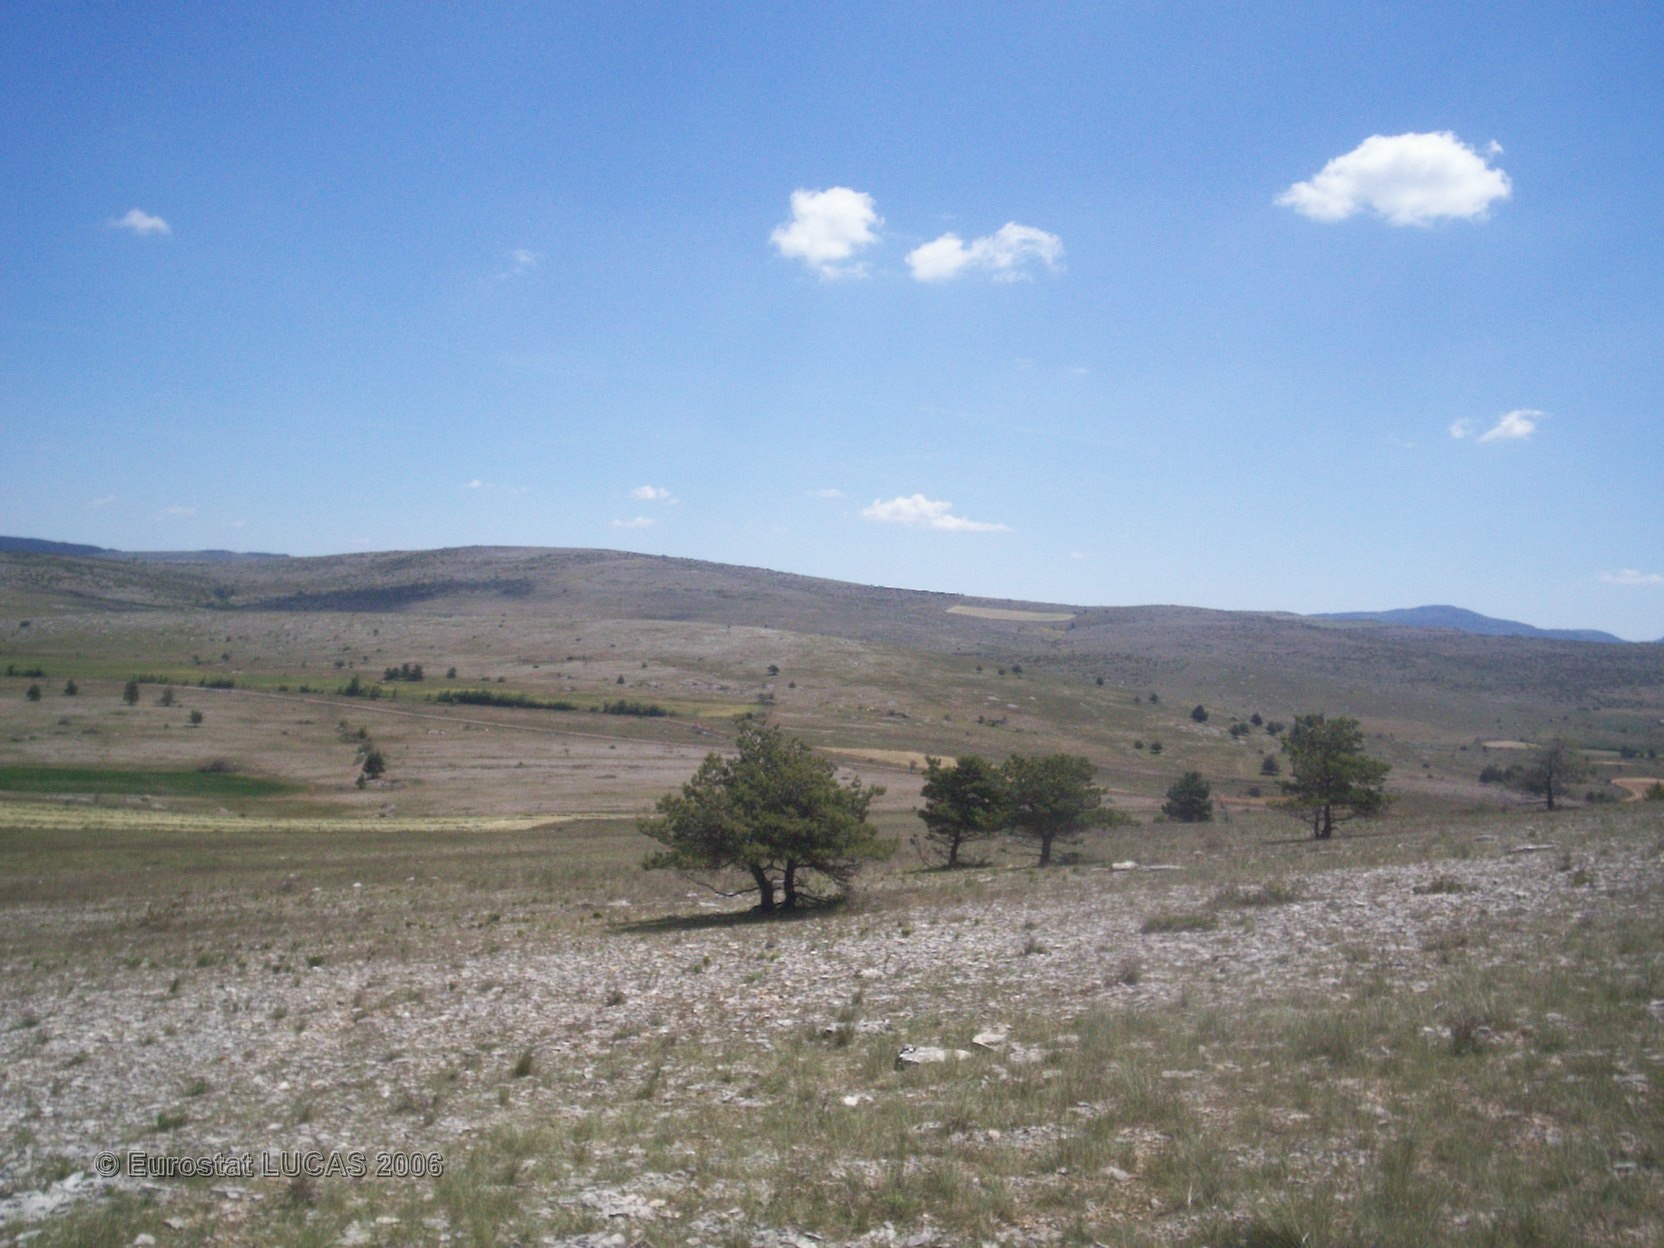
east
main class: Grassland
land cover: Grassland without tree/shrub cover
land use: Agriculture (excluding fallow land and kitchen gardens)
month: June
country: FR
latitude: 44.2134
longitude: 3.4103
